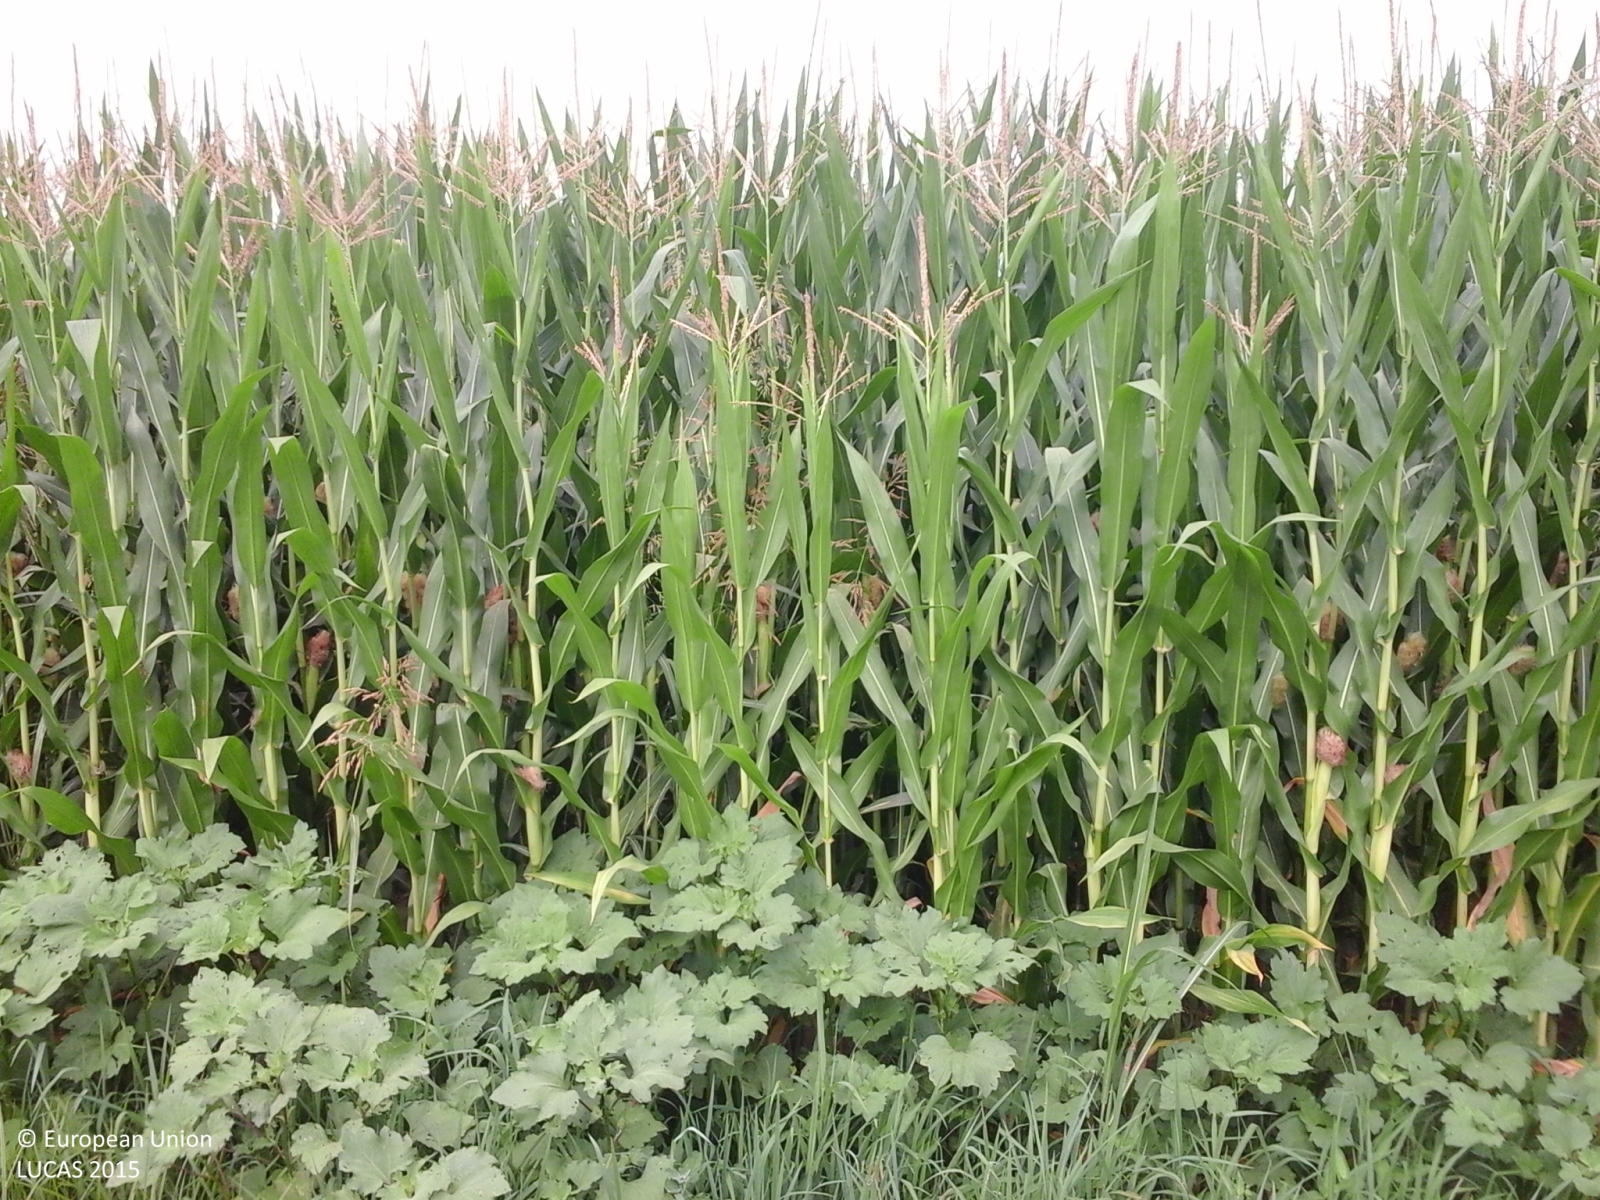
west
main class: Cropland
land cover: Maize
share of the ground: > 75 %
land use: Agriculture (excluding fallow land and kitchen gardens)
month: July
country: IT
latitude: 45.2812
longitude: 8.7911
